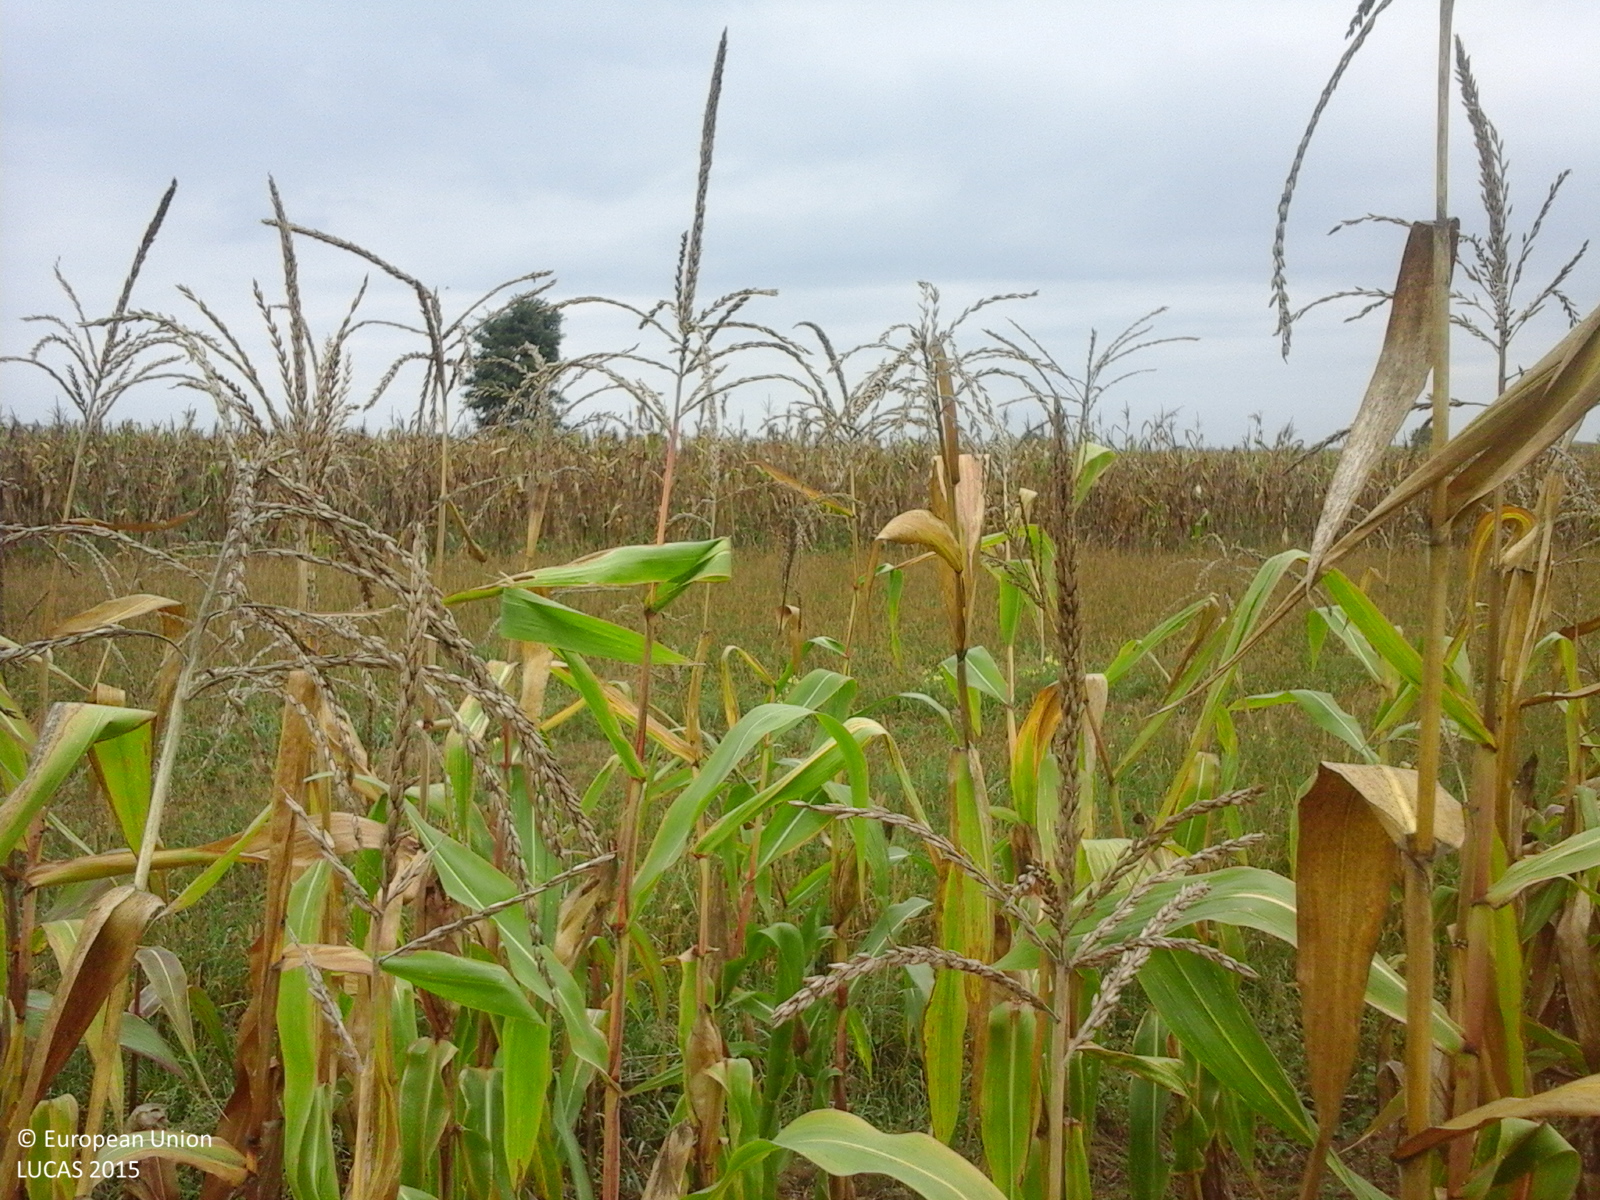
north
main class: Cropland
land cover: Maize
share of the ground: > 75 %
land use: Agriculture (excluding fallow land and kitchen gardens)
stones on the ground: < 10 %
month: September
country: RO
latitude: 45.8280
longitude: 22.2340
